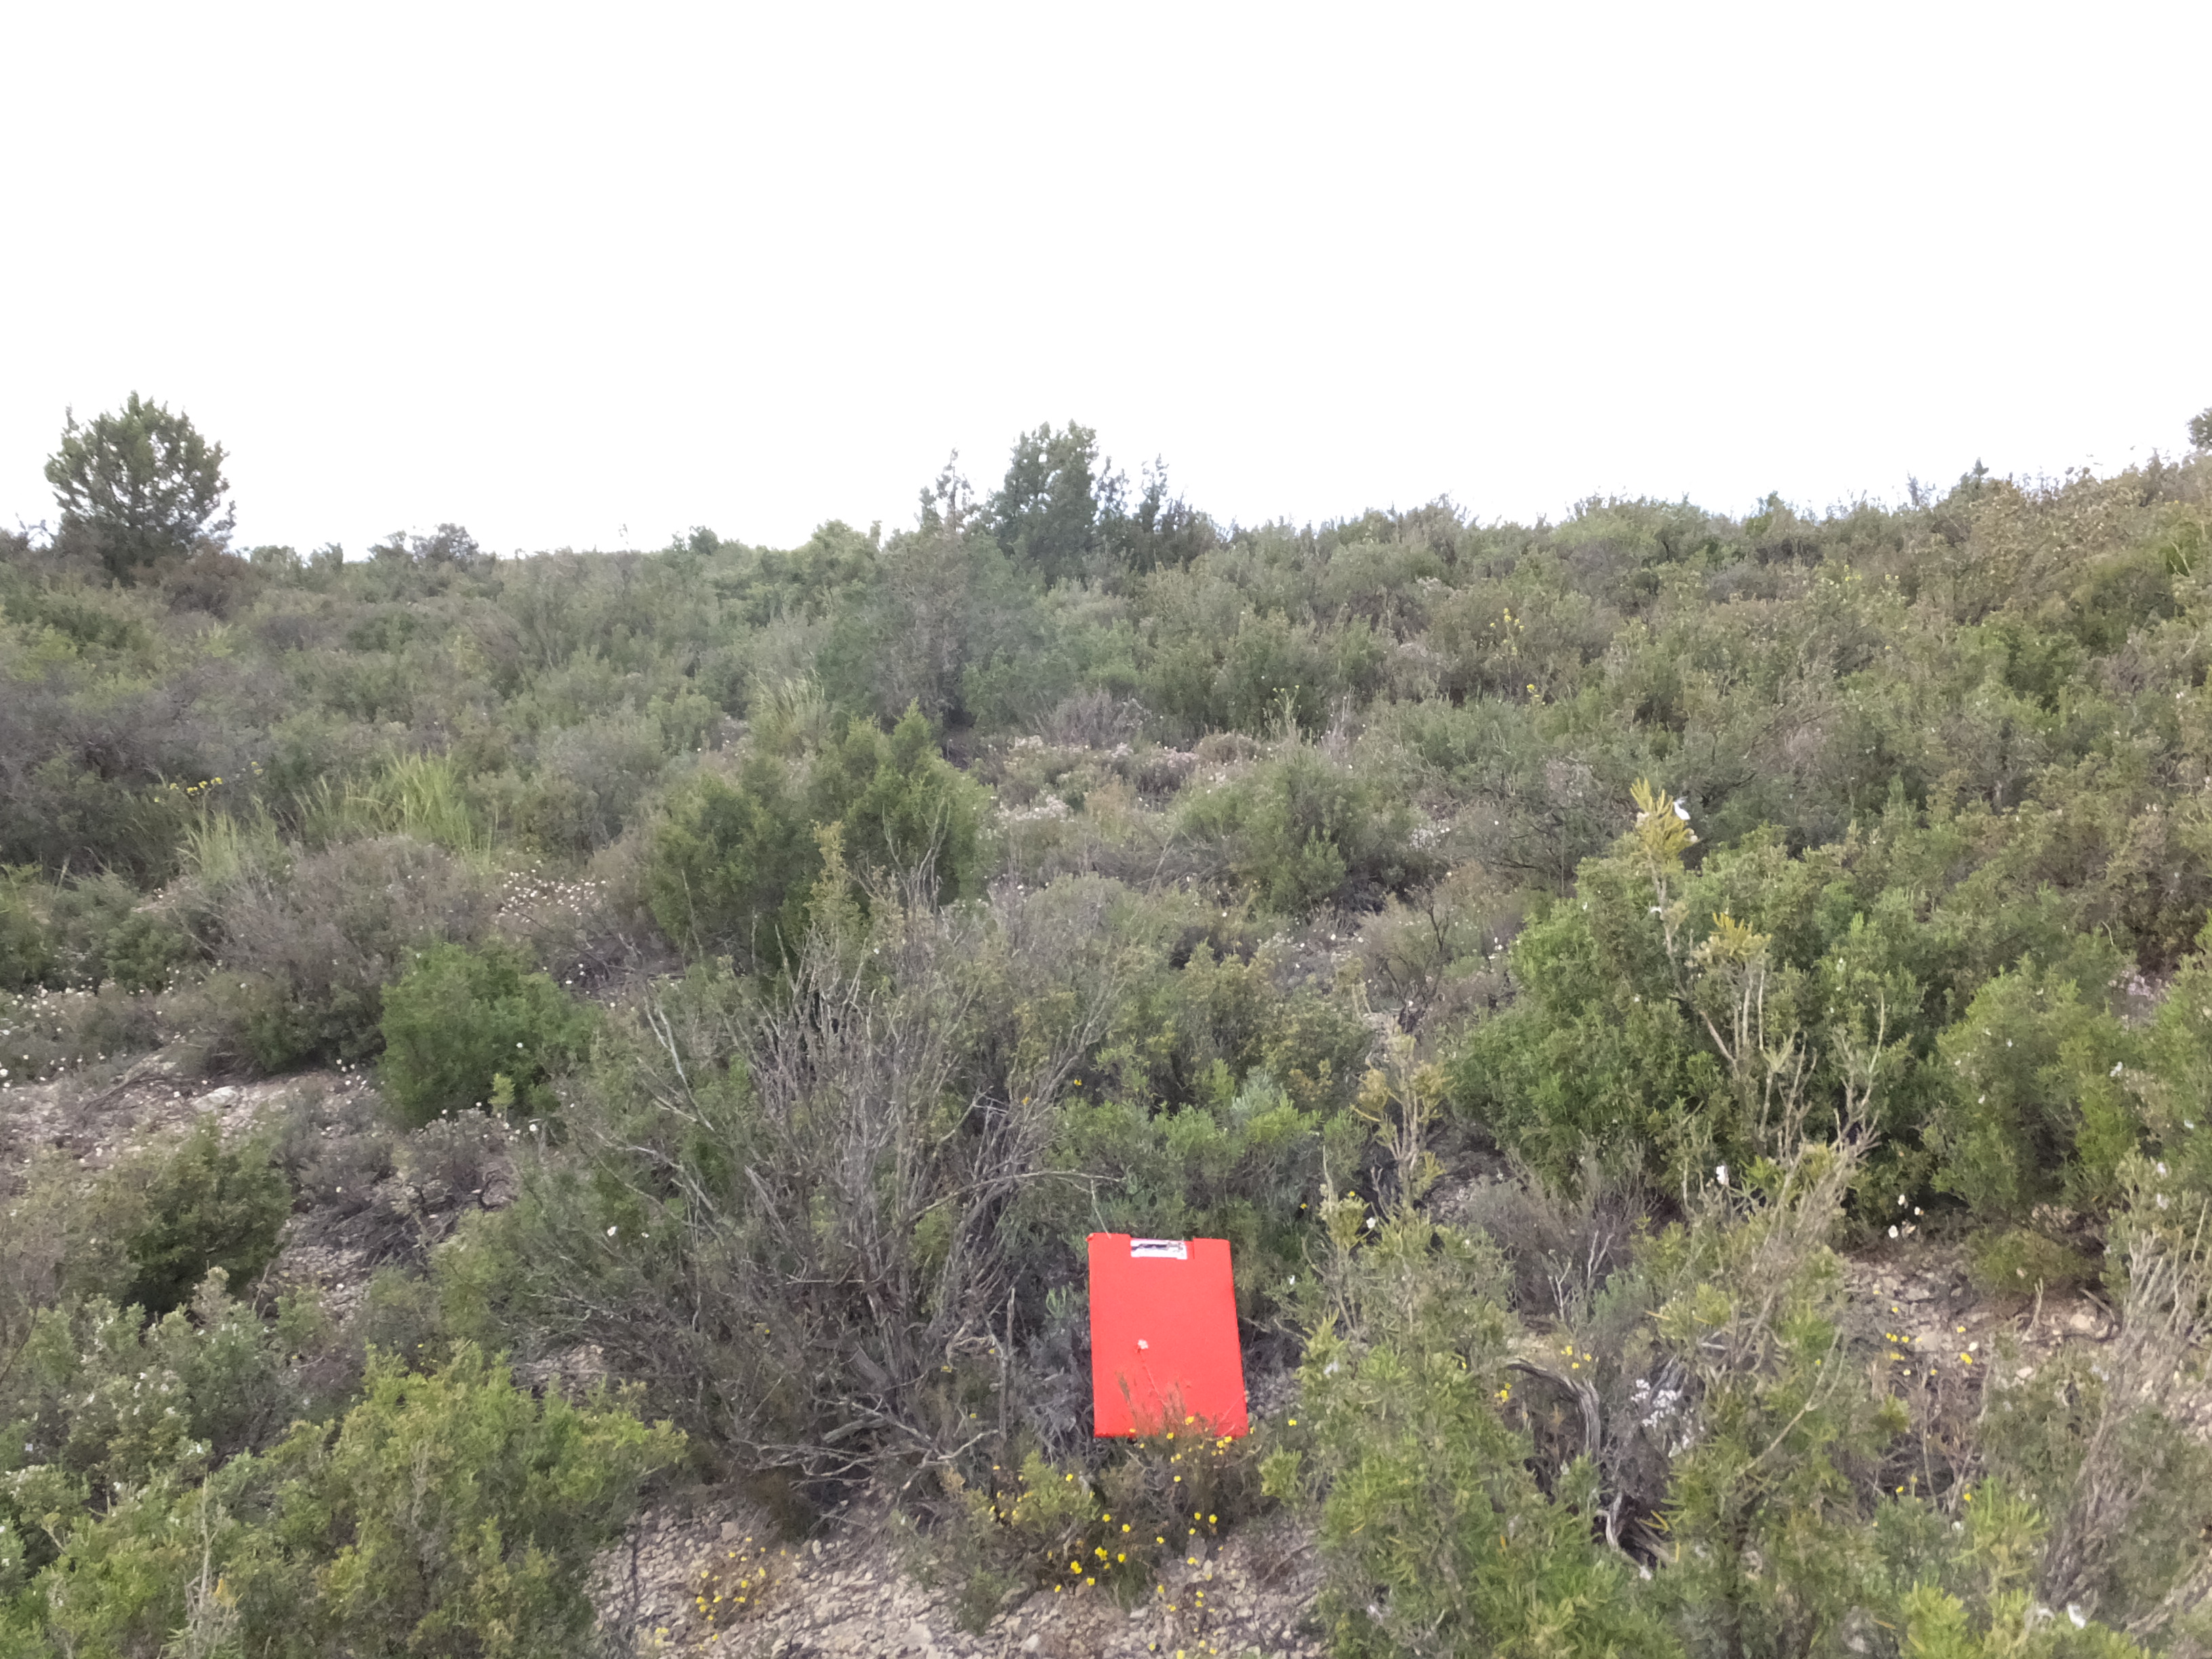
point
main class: Shrubland
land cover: Shrubland with sparse tree cover
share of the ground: > 75 %
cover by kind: shrubs 95 %, coniferous forest trees 5 %
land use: Semi-natural and natural areas not in use
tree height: < 5 m
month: April
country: ES
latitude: 41.6357
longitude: -0.3055
